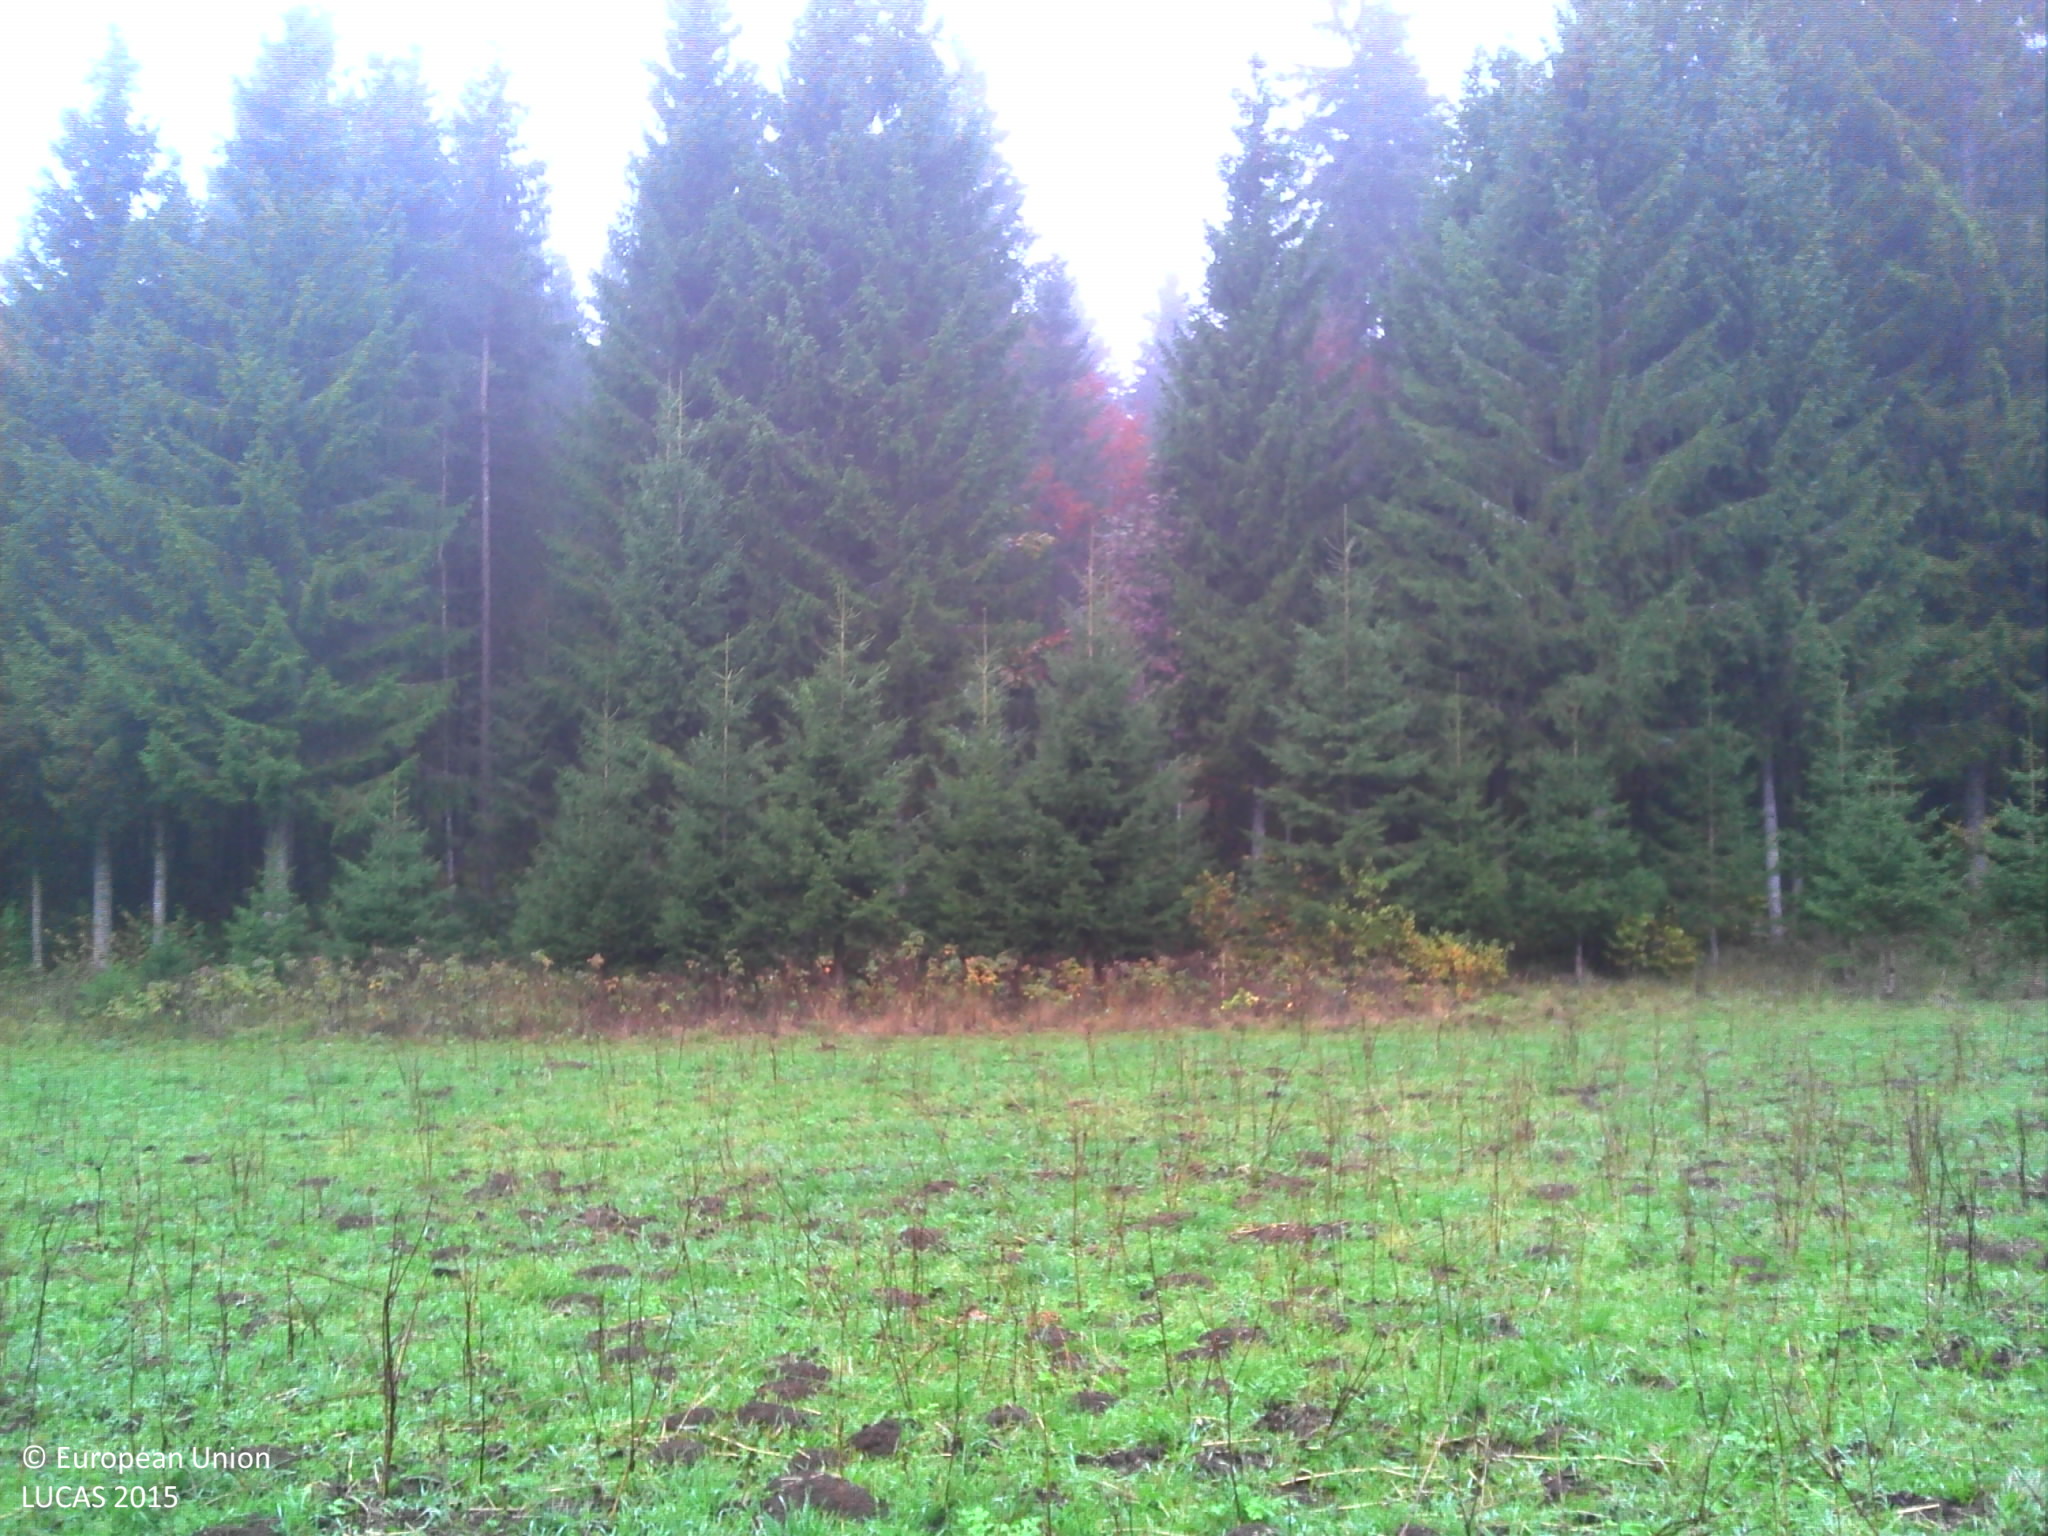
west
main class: Grassland
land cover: Grassland without tree/shrub cover
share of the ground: > 75 %
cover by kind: herbaceous plants 100 %
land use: Agriculture (excluding fallow land and kitchen gardens)
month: October
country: FR
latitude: 46.8269
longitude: 6.2664
